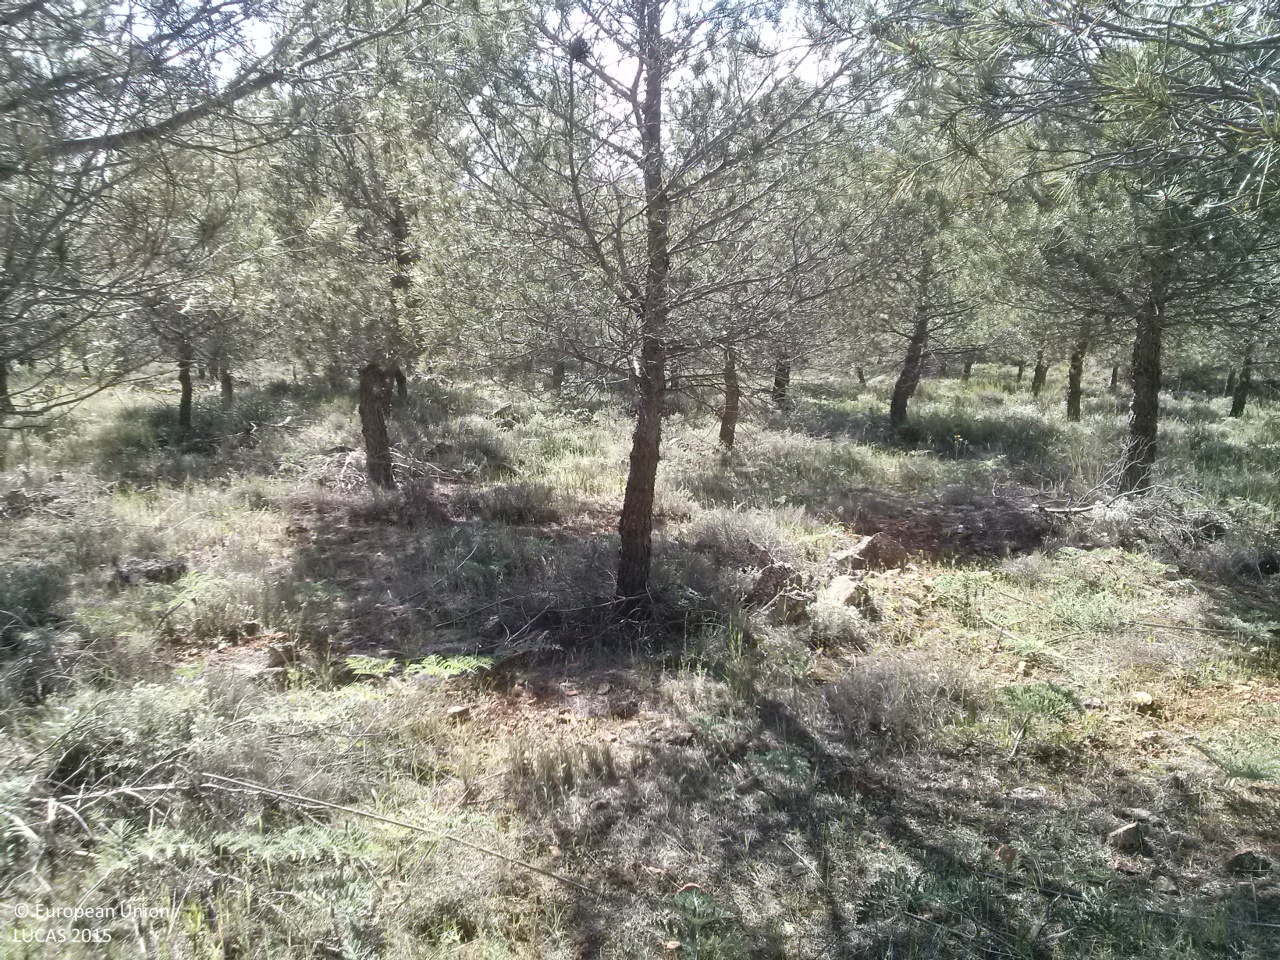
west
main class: Woodland
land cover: Pine dominated coniferous woodland
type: coniferous forest of the mediterranean region
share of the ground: 50 - 75 %
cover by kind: coniferous forest trees 65 %, herbaceous plants 25 %, consolidated bare surface 10 %
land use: Forestry
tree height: < 5 m
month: May
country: ES
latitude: 39.8320
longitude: -2.7670
